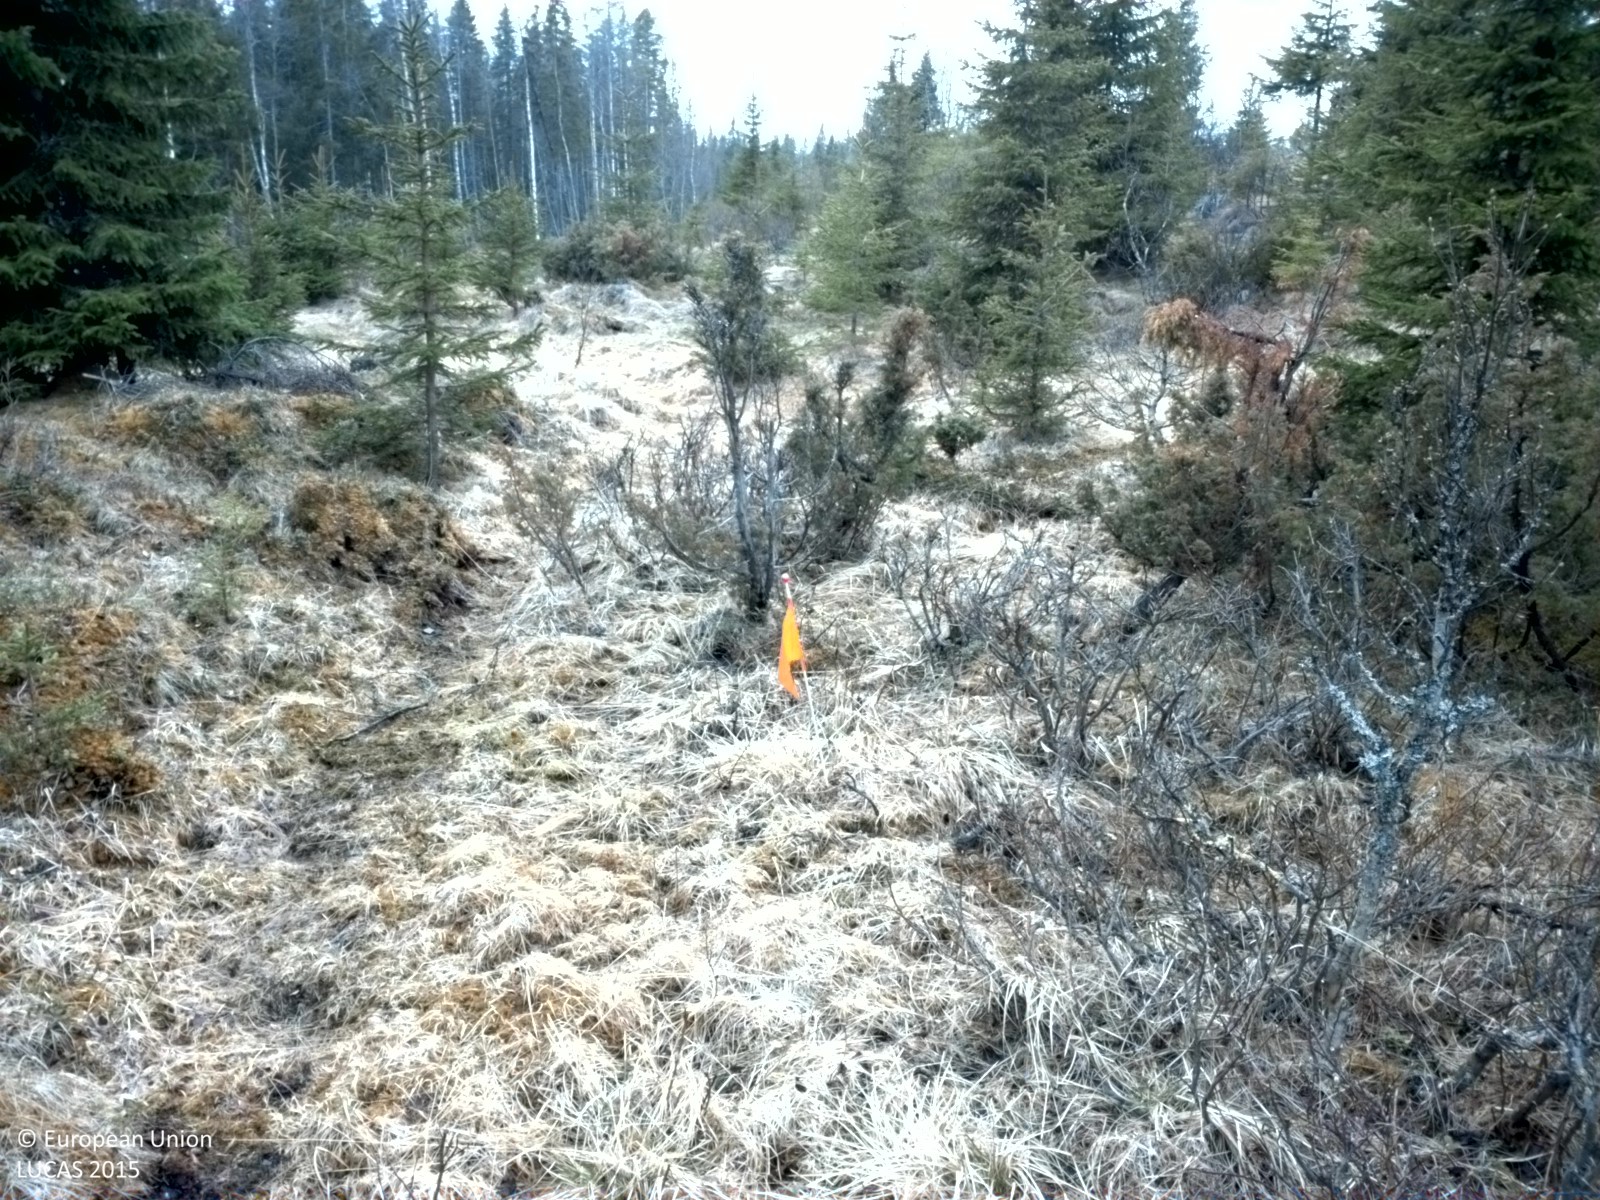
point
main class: Woodland
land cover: Spruce dominated mixed woodland
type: boreal forest
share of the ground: > 75 %
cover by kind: coniferous forest trees 50 %, shrubs 30 %, broadleaved forest trees 20 %
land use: Forestry
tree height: < 5 m
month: May
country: SE
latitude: 63.4118
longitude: 13.8456
